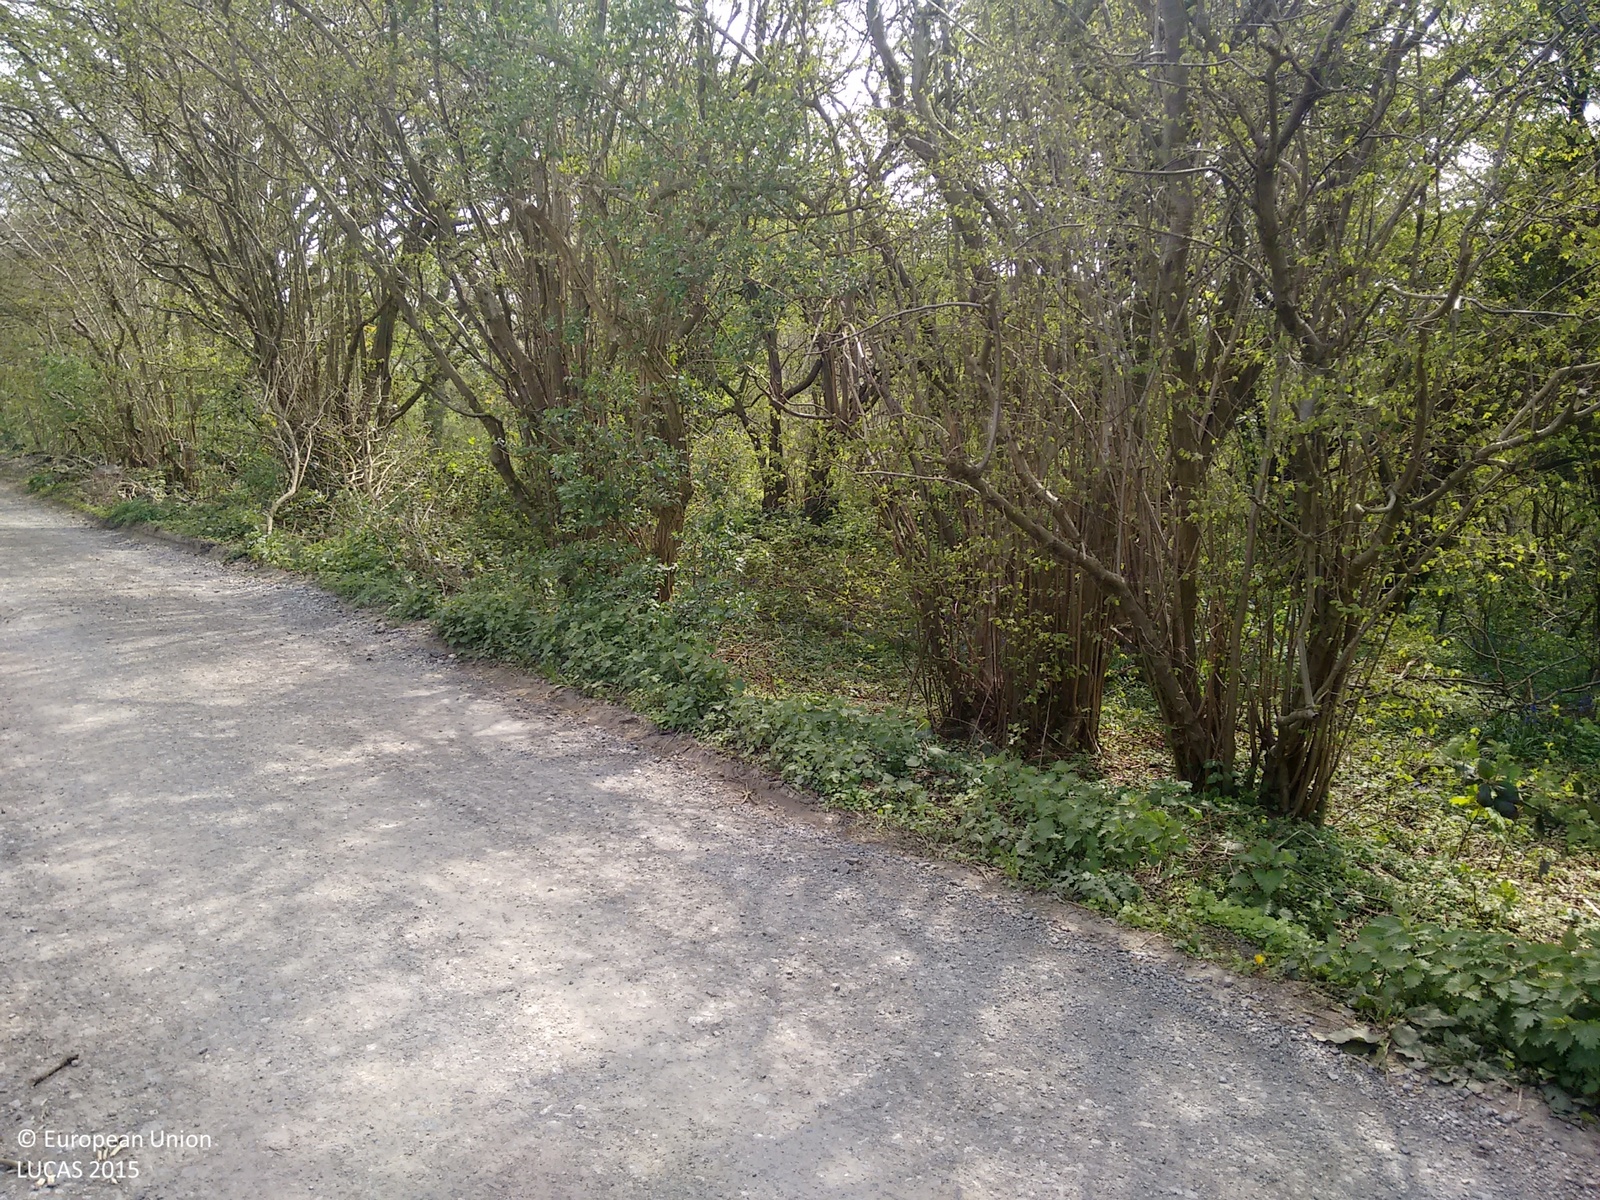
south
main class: Grassland
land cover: Grassland without tree/shrub cover
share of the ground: > 75 %
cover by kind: herbaceous plants 80 %, unconsolidated bare surface 20 %
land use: Agriculture (excluding fallow land and kitchen gardens)
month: April
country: GB
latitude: 51.3425
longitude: 0.4827
